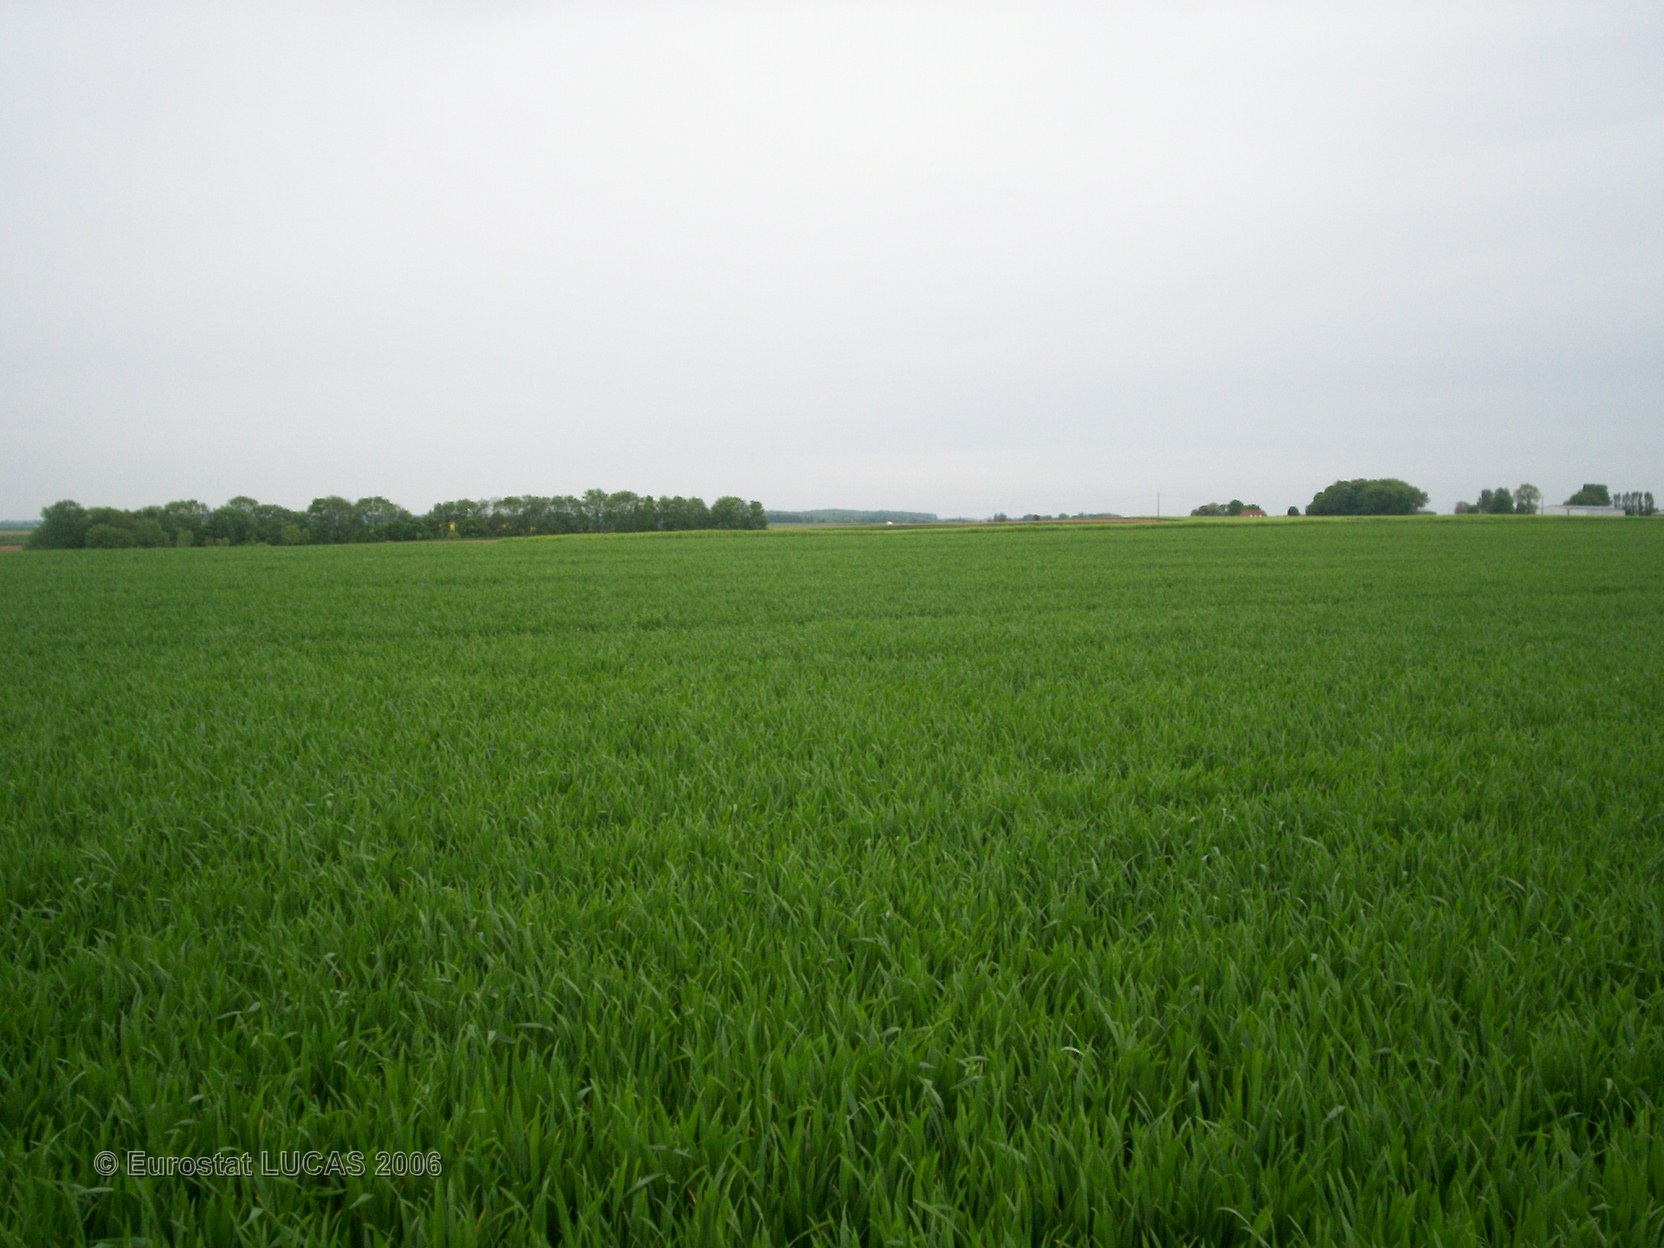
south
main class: Cropland
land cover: Common wheat
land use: Agriculture (excluding fallow land and kitchen gardens)
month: May
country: FR
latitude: 50.2898
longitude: 2.6475
